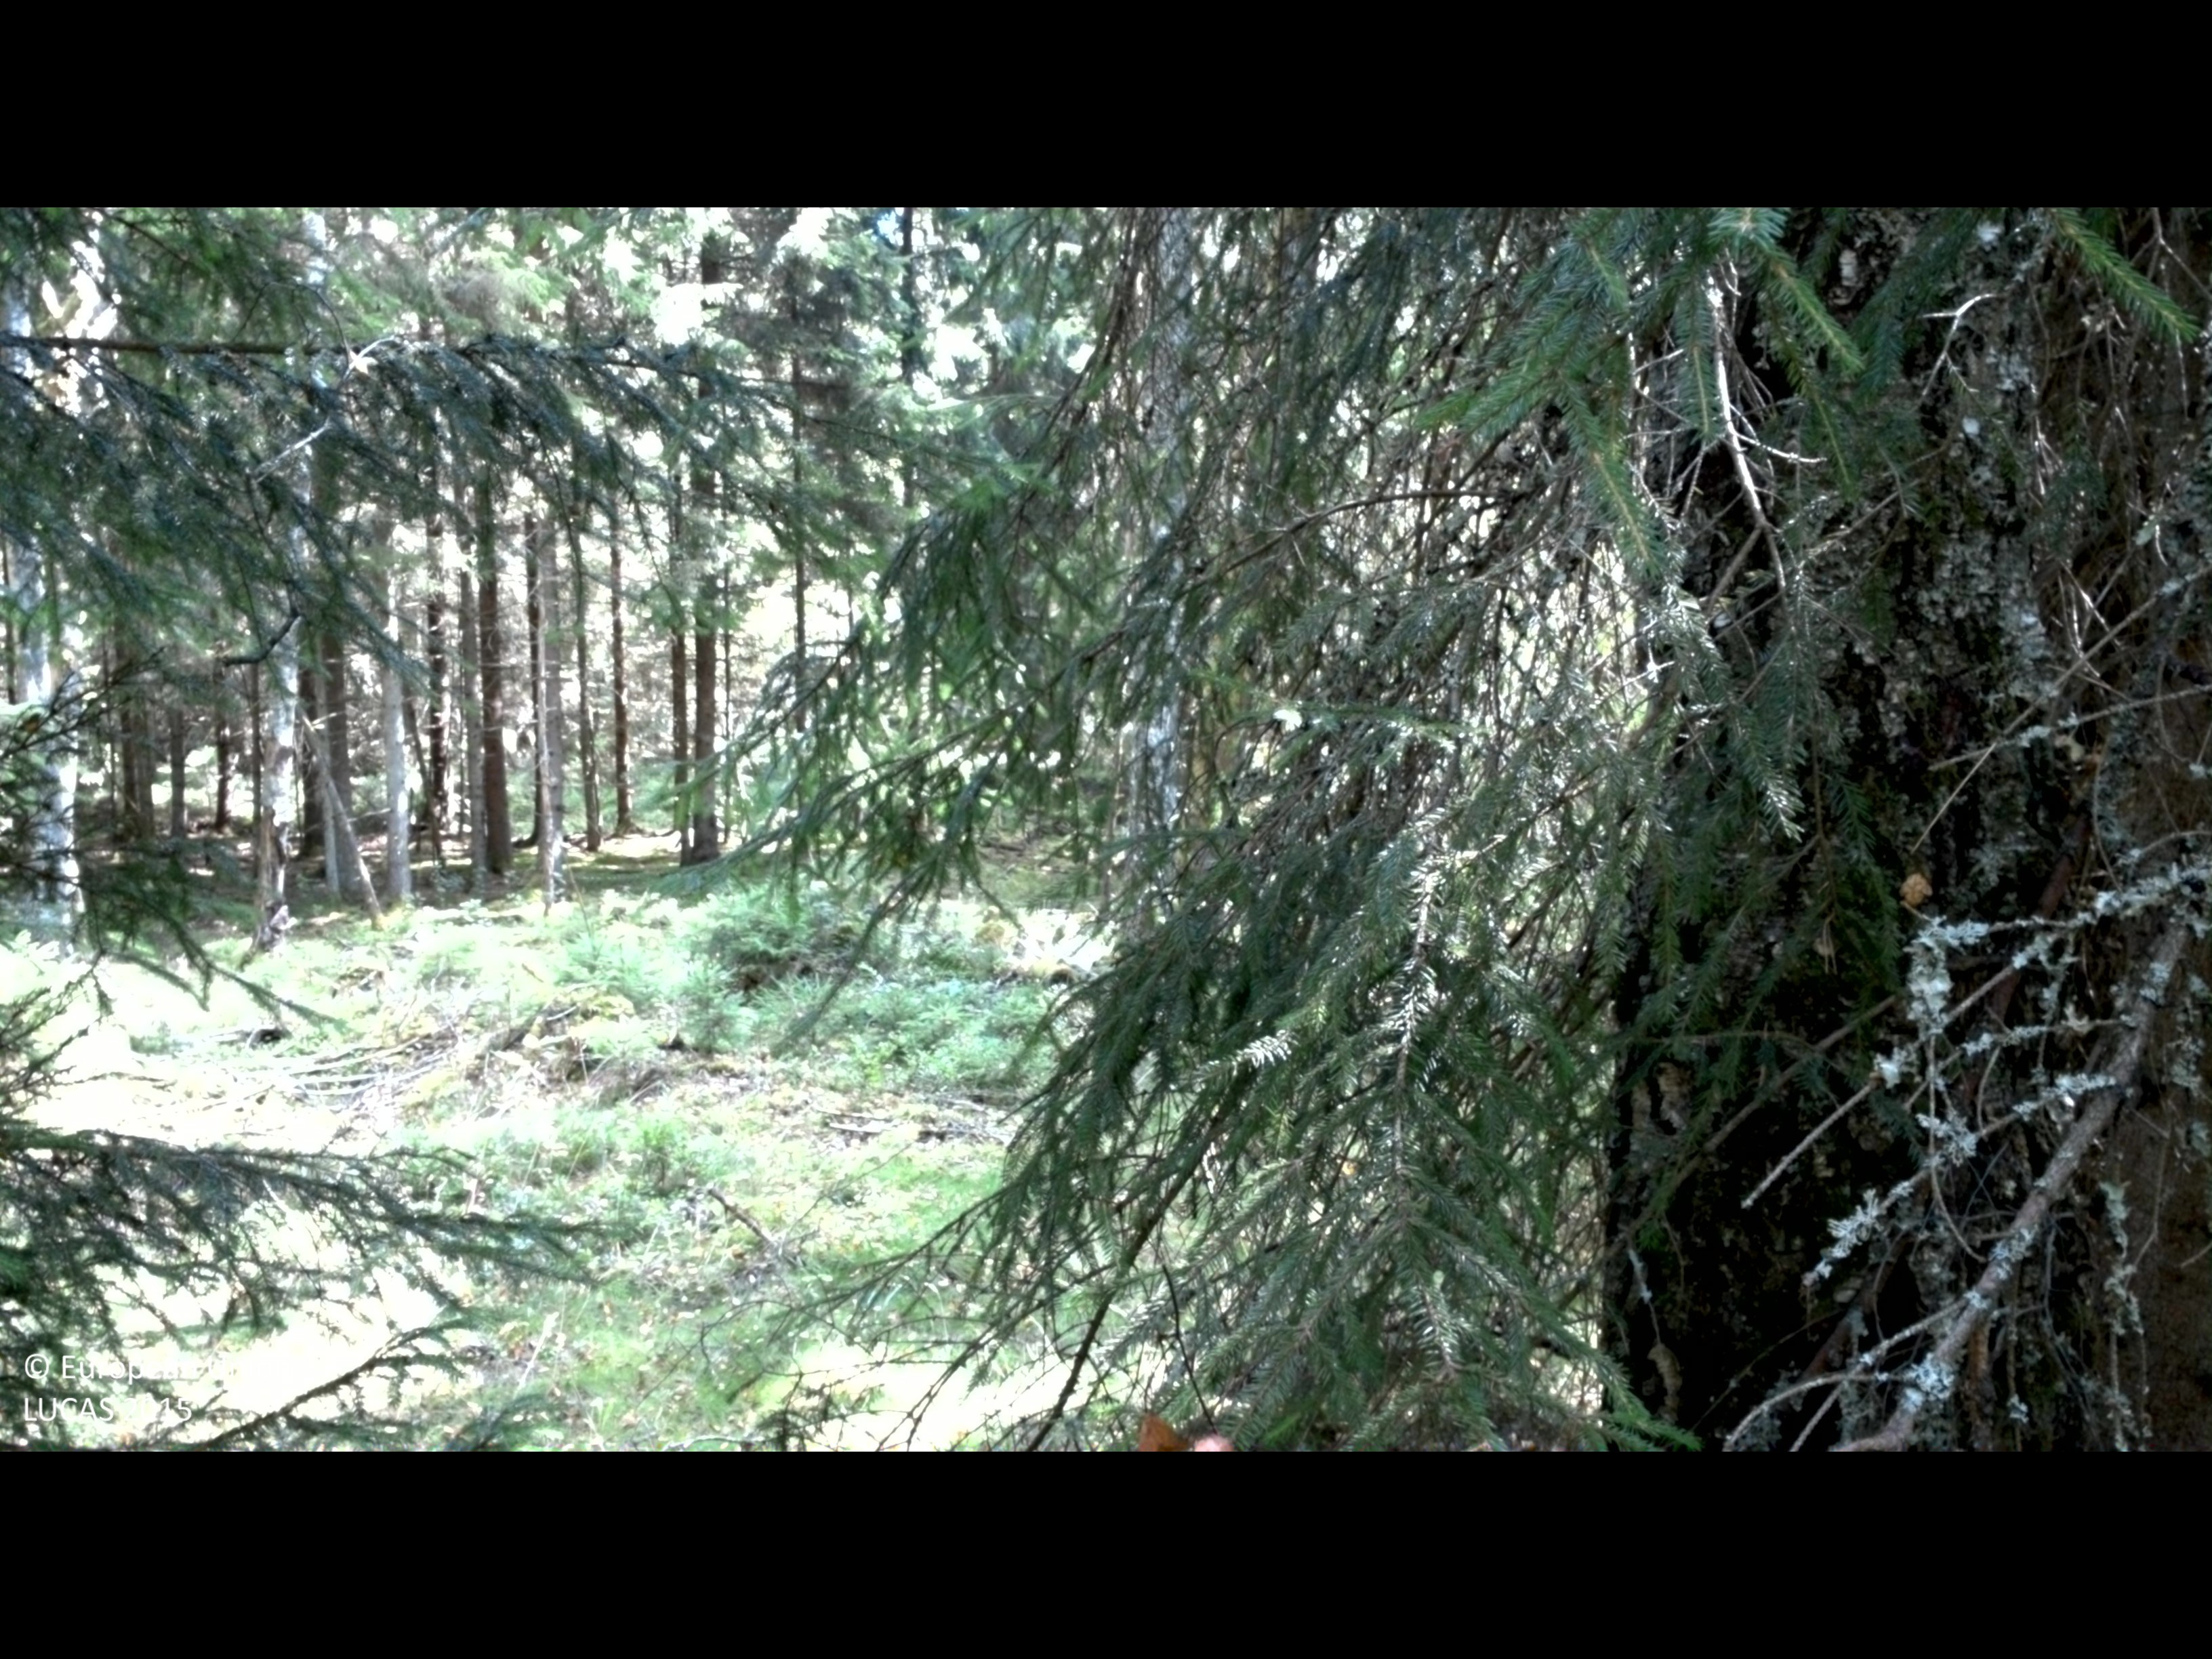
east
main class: Woodland
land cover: Spruce dominated mixed woodland
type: boreal forest
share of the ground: > 75 %
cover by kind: coniferous forest trees 50 %, broadleaved forest trees 30 %, shrubs 15 %, herbaceous plants 5 %
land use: Forestry
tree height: > 5 m
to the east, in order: Spruce dominated mixed woodland; Rivers and streams; Spruce dominated mixed woodland; Ditches and canals; Spruce dominated mixed woodland
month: August
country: SE
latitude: 56.7450
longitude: 14.3299
